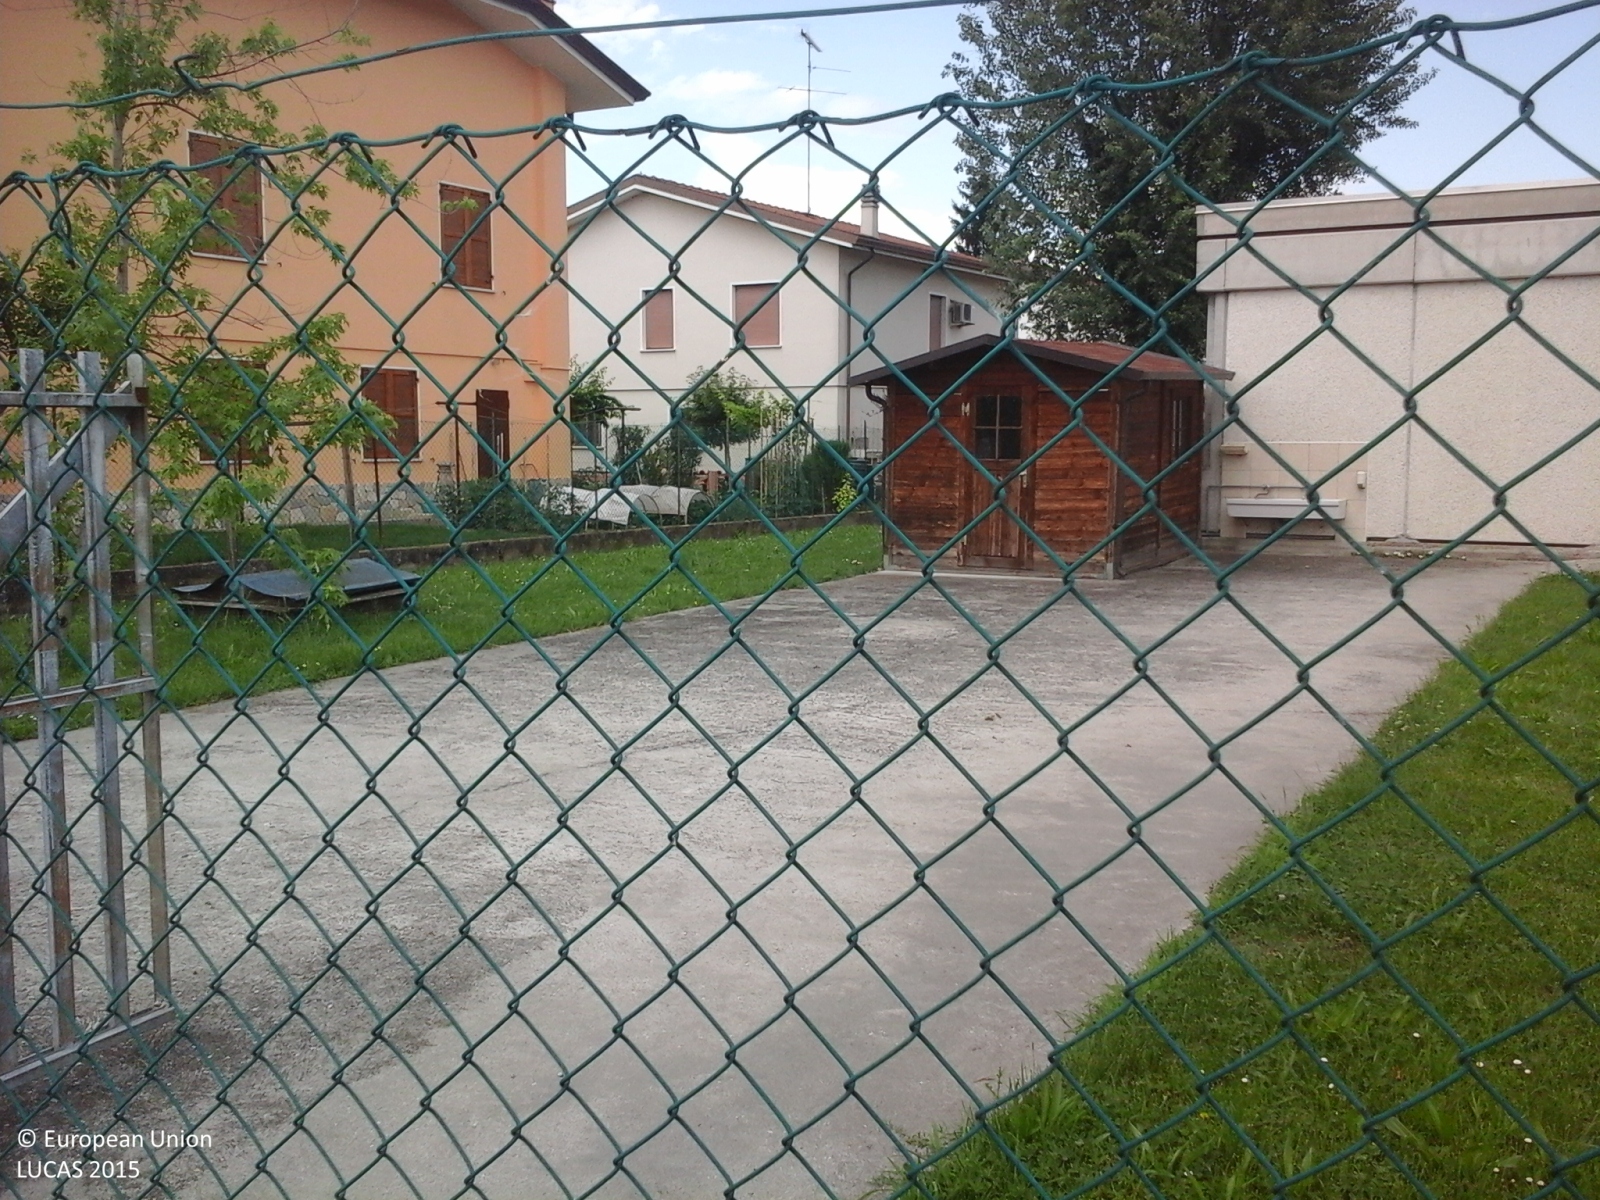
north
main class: Grassland
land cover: Grassland without tree/shrub cover
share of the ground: > 75 %
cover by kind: herbaceous plants 100 %
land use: Community services
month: May
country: IT
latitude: 45.0511
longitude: 10.7477
